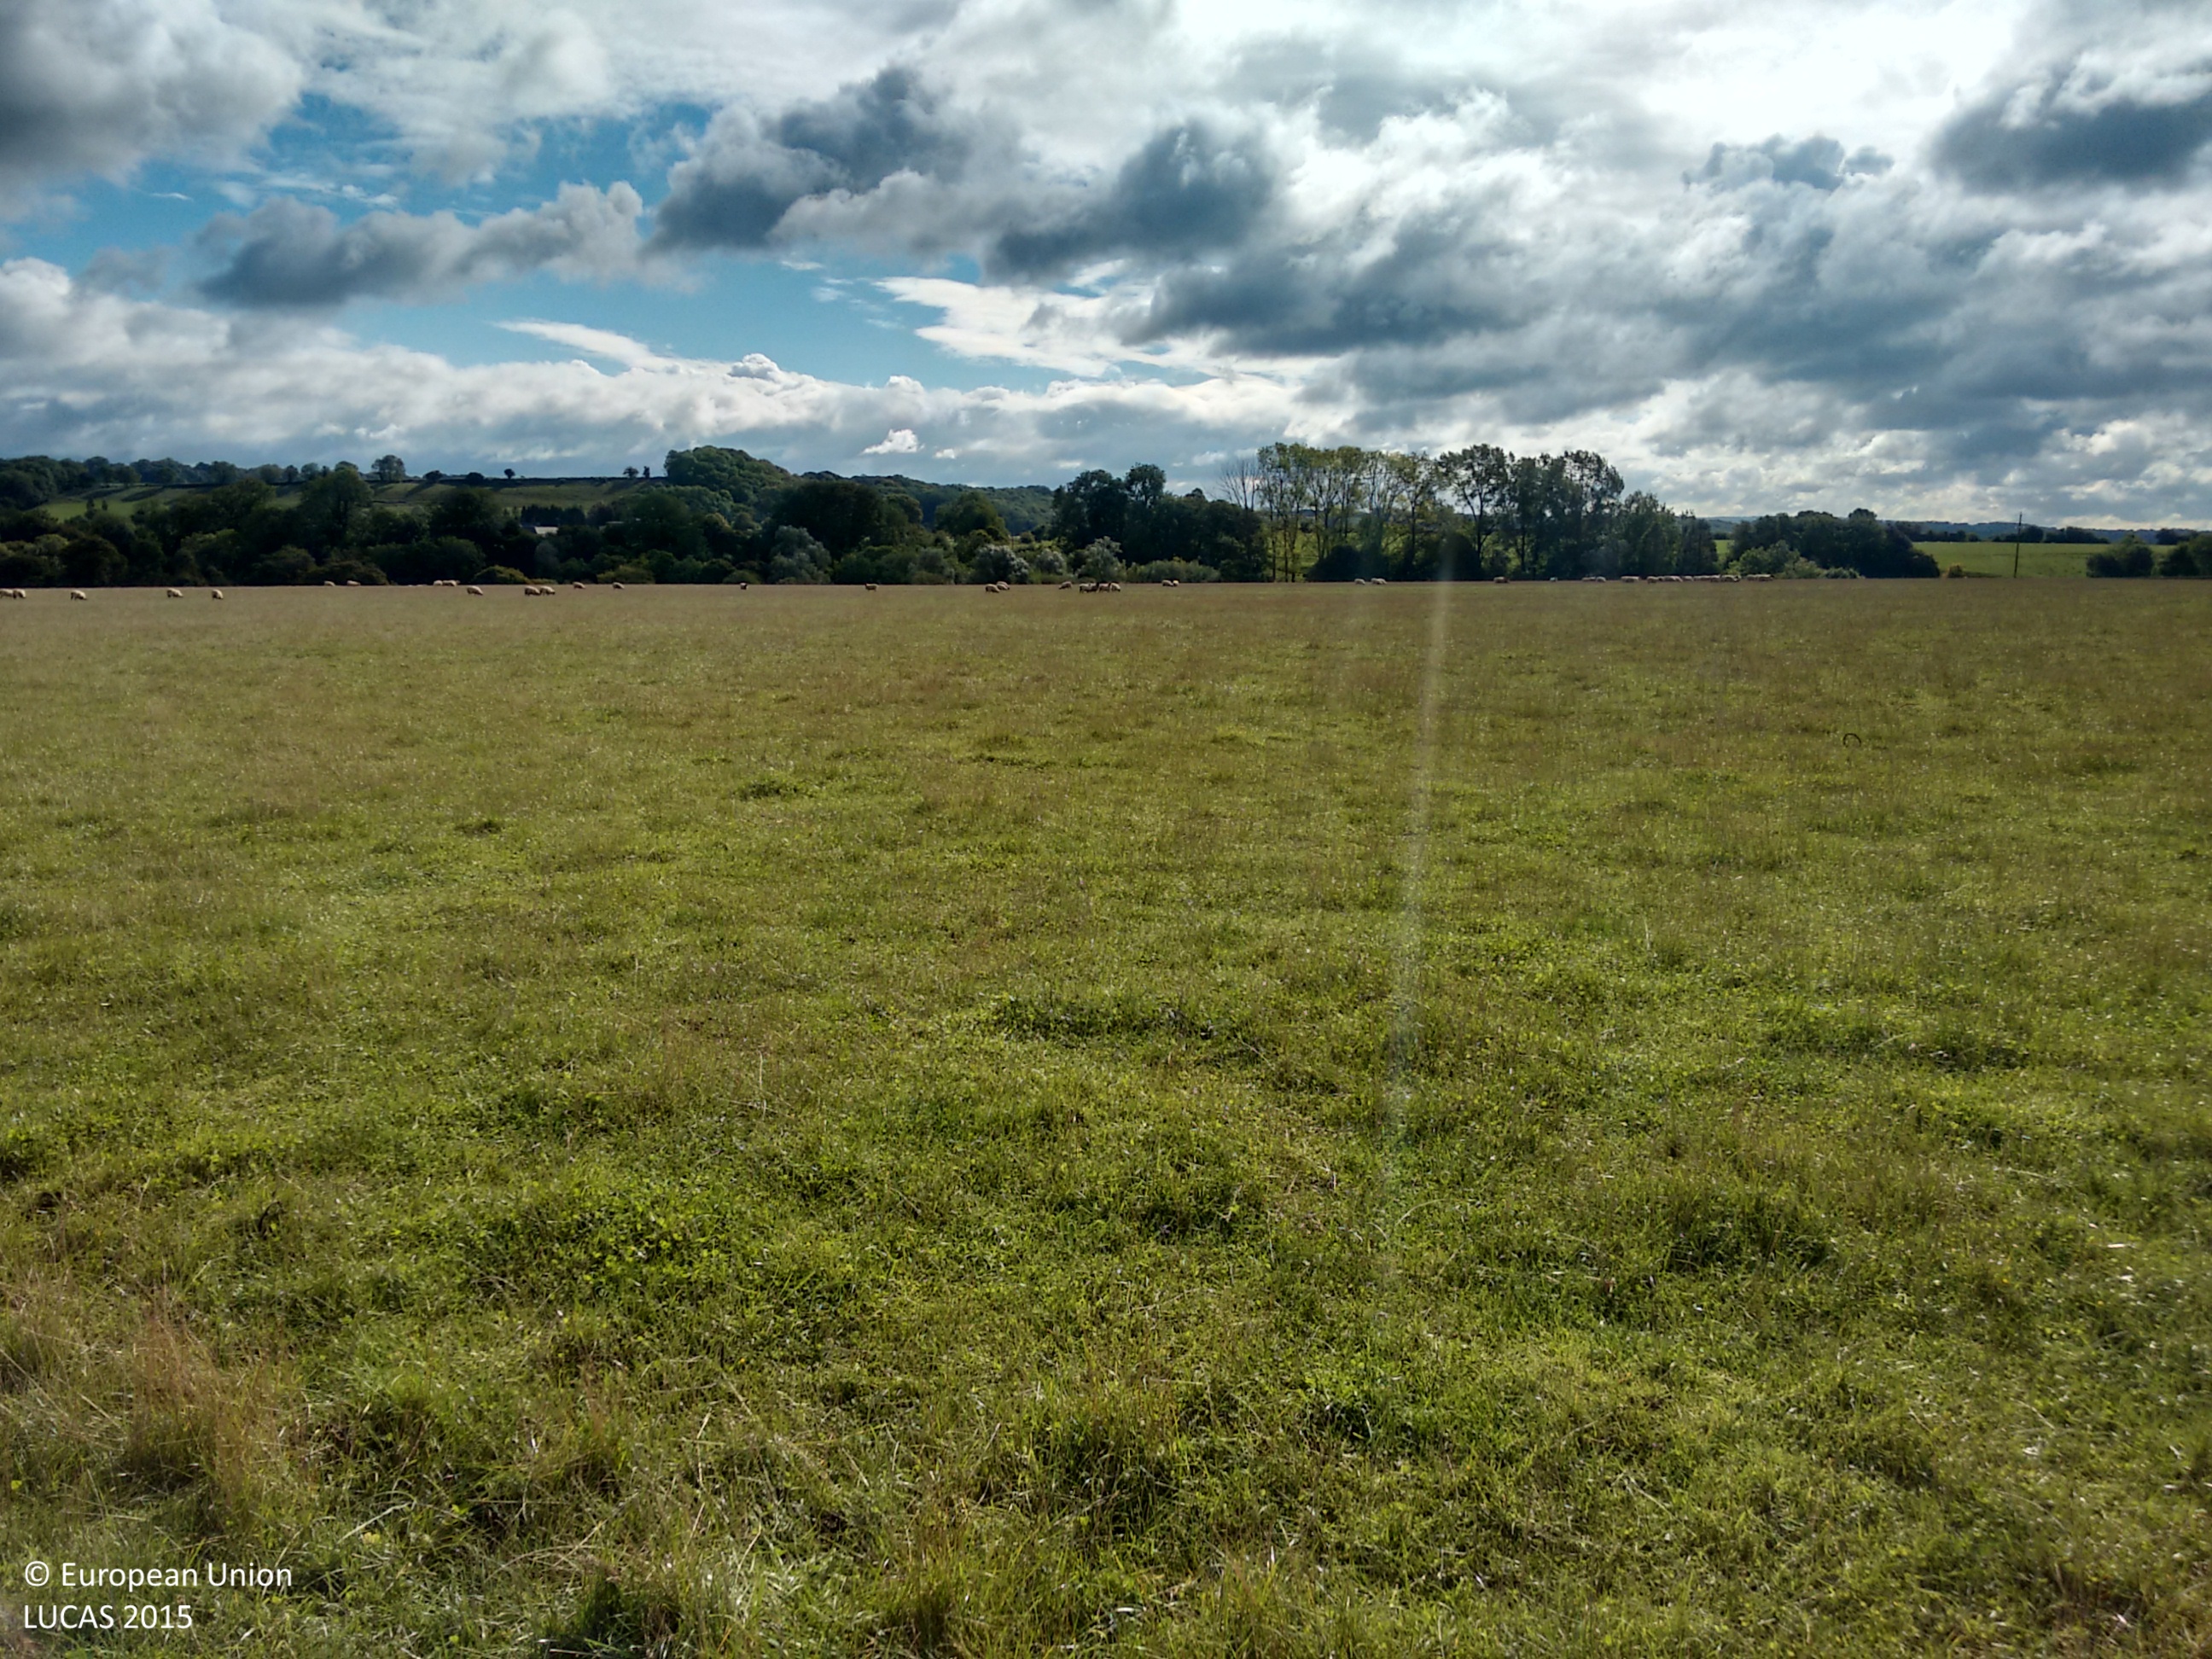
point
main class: Grassland
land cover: Grassland without tree/shrub cover
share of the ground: > 75 %
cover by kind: herbaceous plants 100 %
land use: Agriculture (excluding fallow land and kitchen gardens)
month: September
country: GB
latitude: 50.9883
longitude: -2.4742
